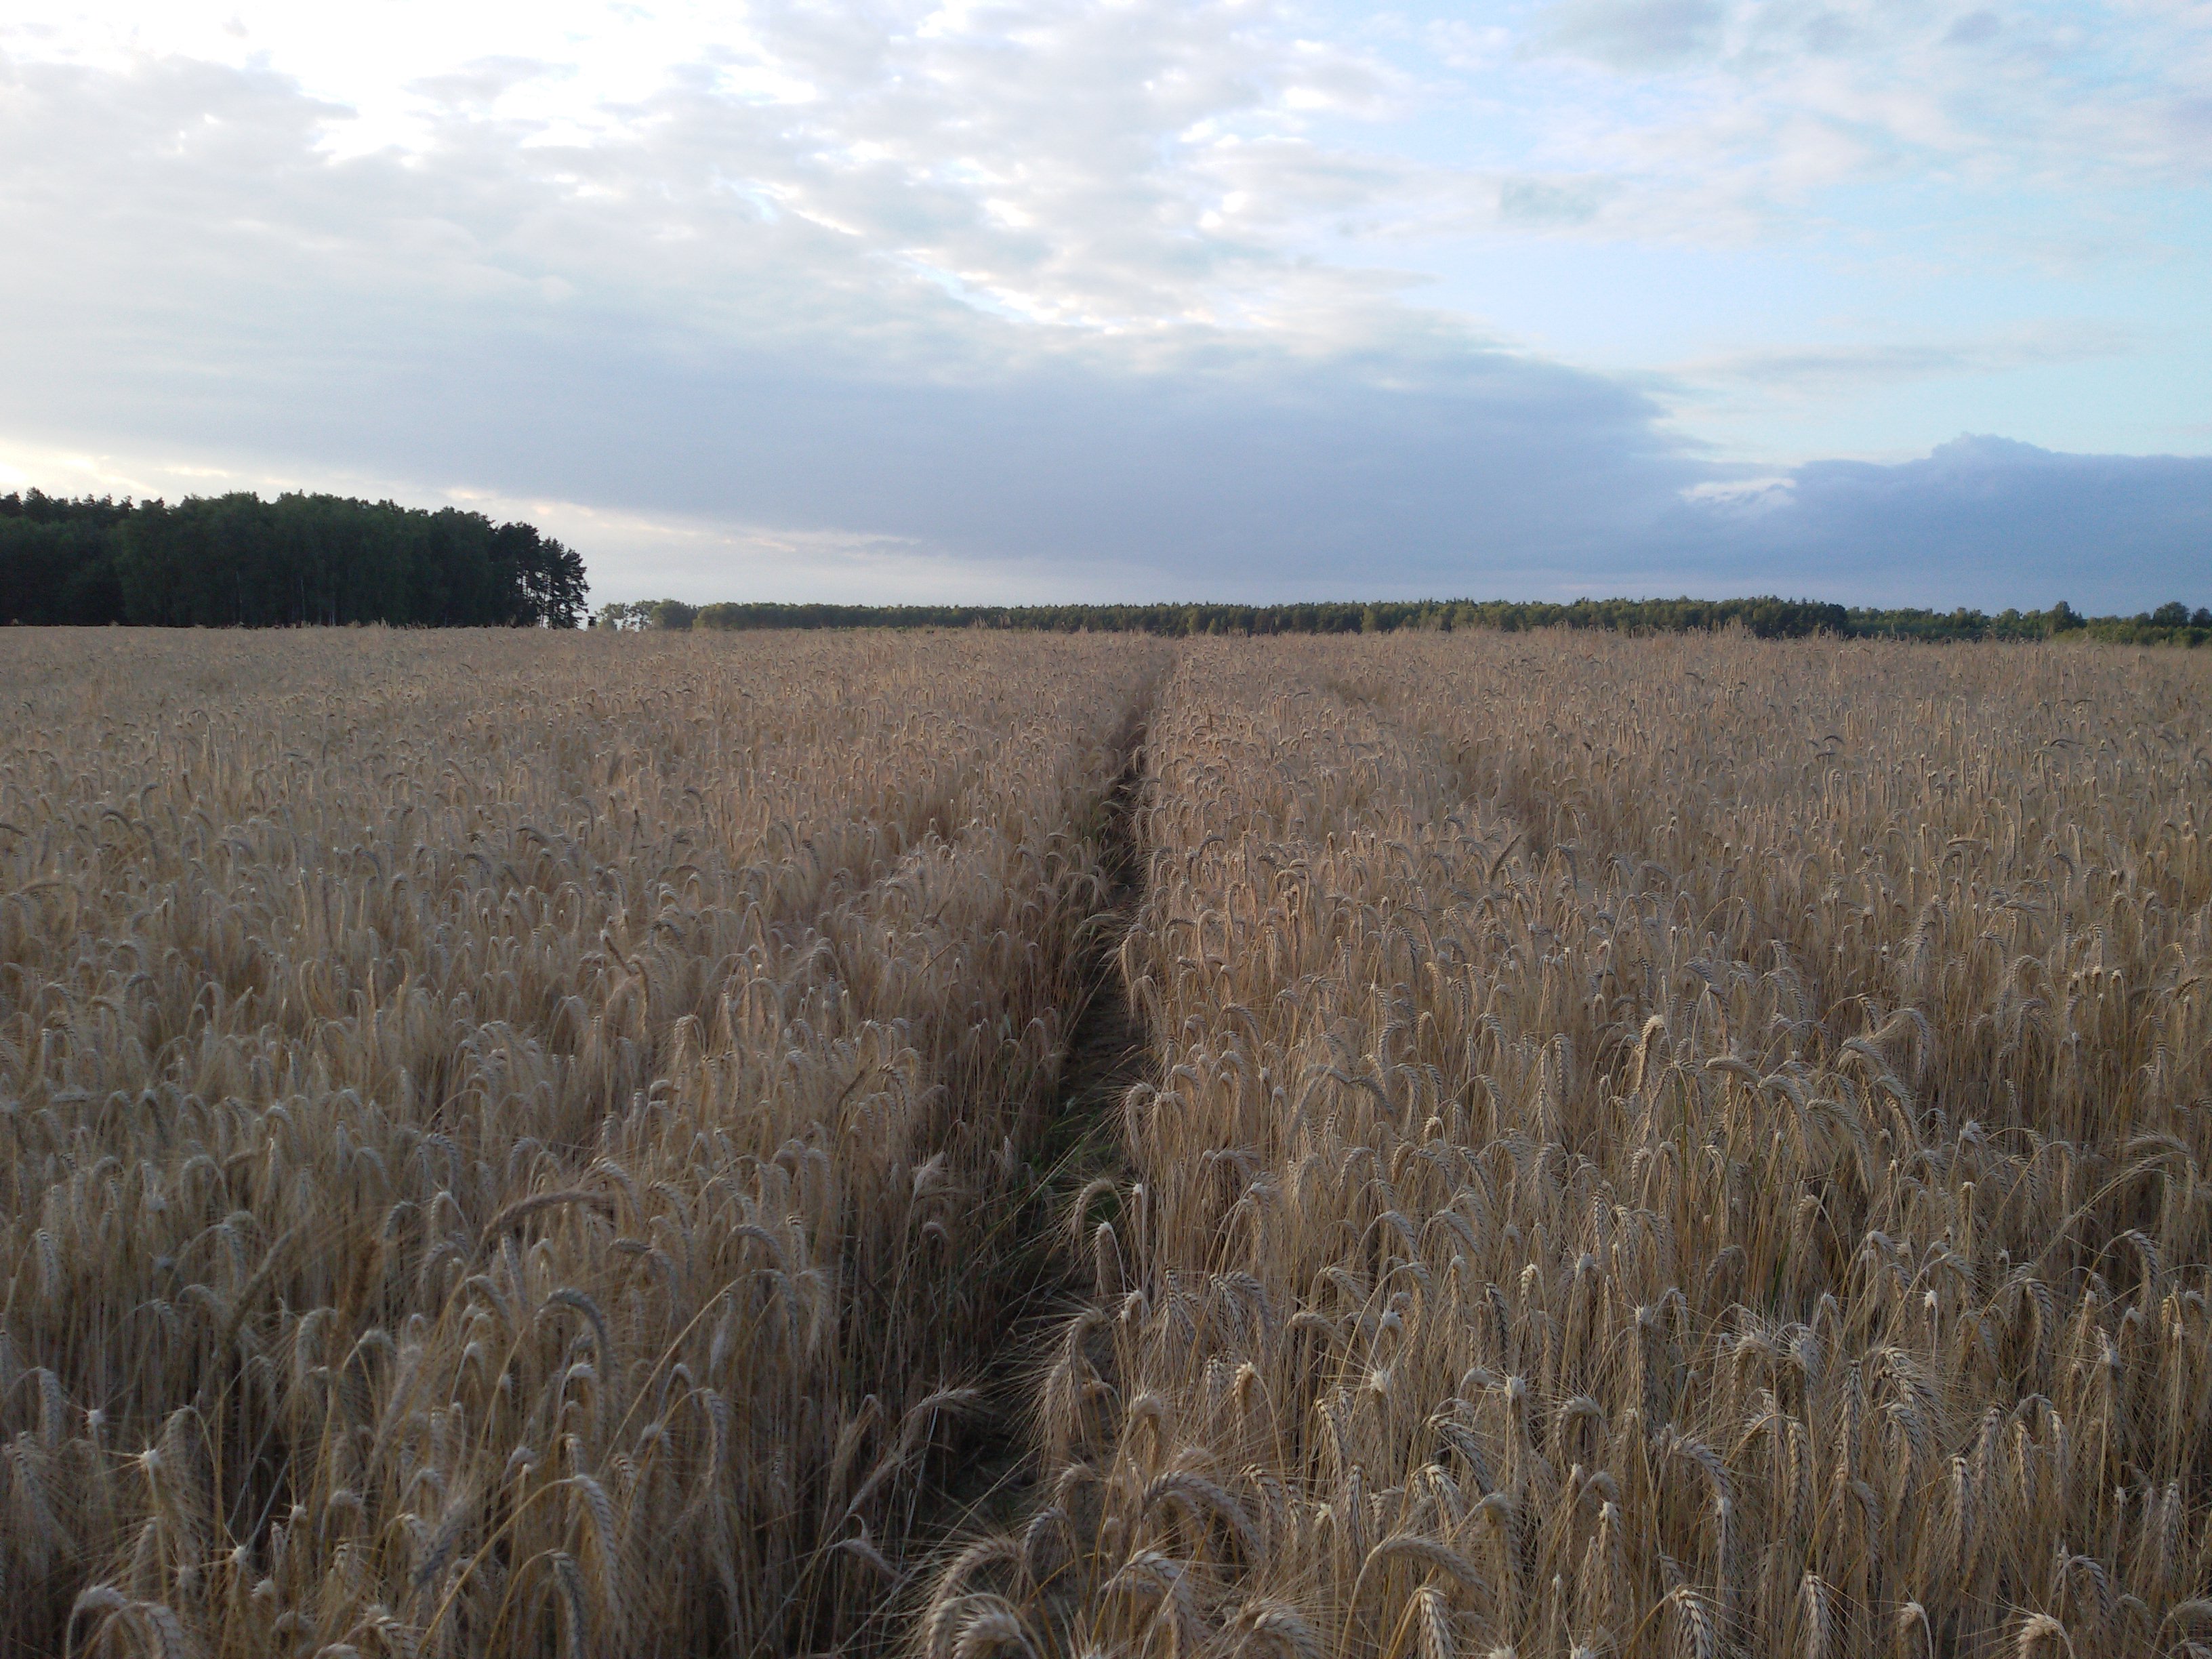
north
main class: Cropland
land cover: Triticale
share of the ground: > 75 %
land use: Agriculture (excluding fallow land and kitchen gardens)
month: July
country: PL
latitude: 52.8026
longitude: 16.9959
